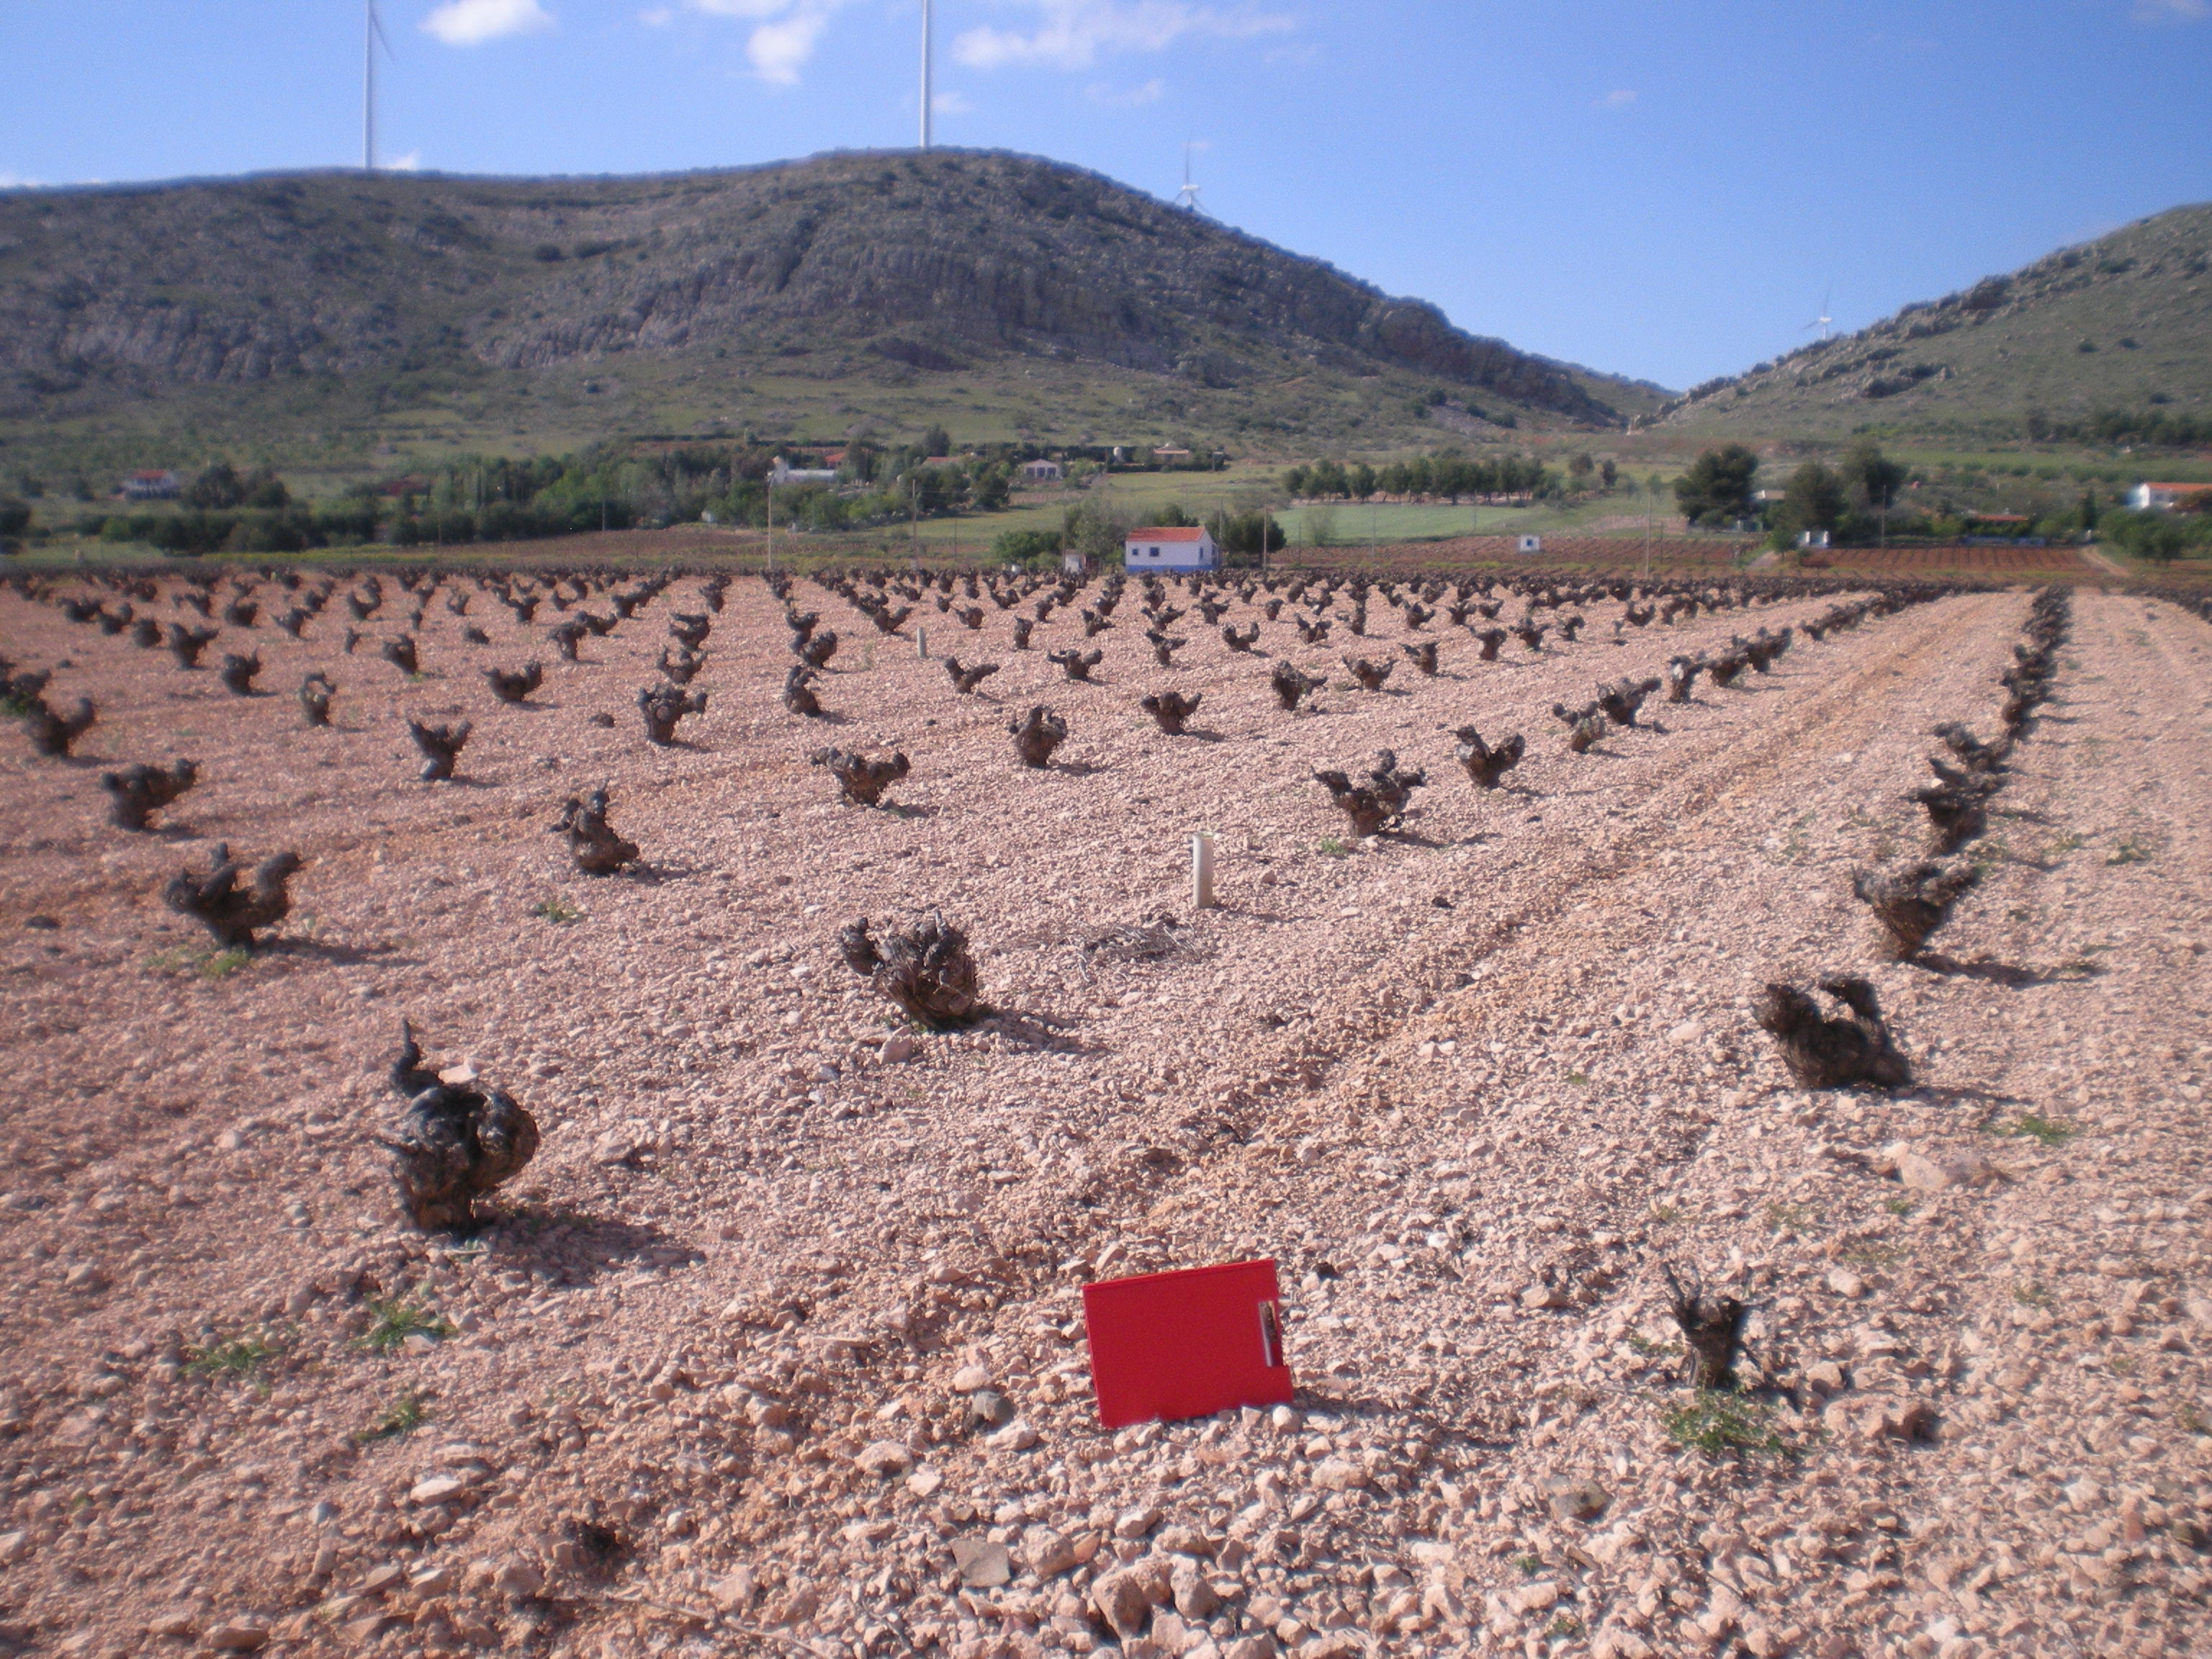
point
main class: Cropland
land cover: Vineyards
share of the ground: < 10 %
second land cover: Other bare soil
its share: > 75 %
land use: Agriculture (excluding fallow land and kitchen gardens)
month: April
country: ES
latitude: 38.8215
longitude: -3.5936
